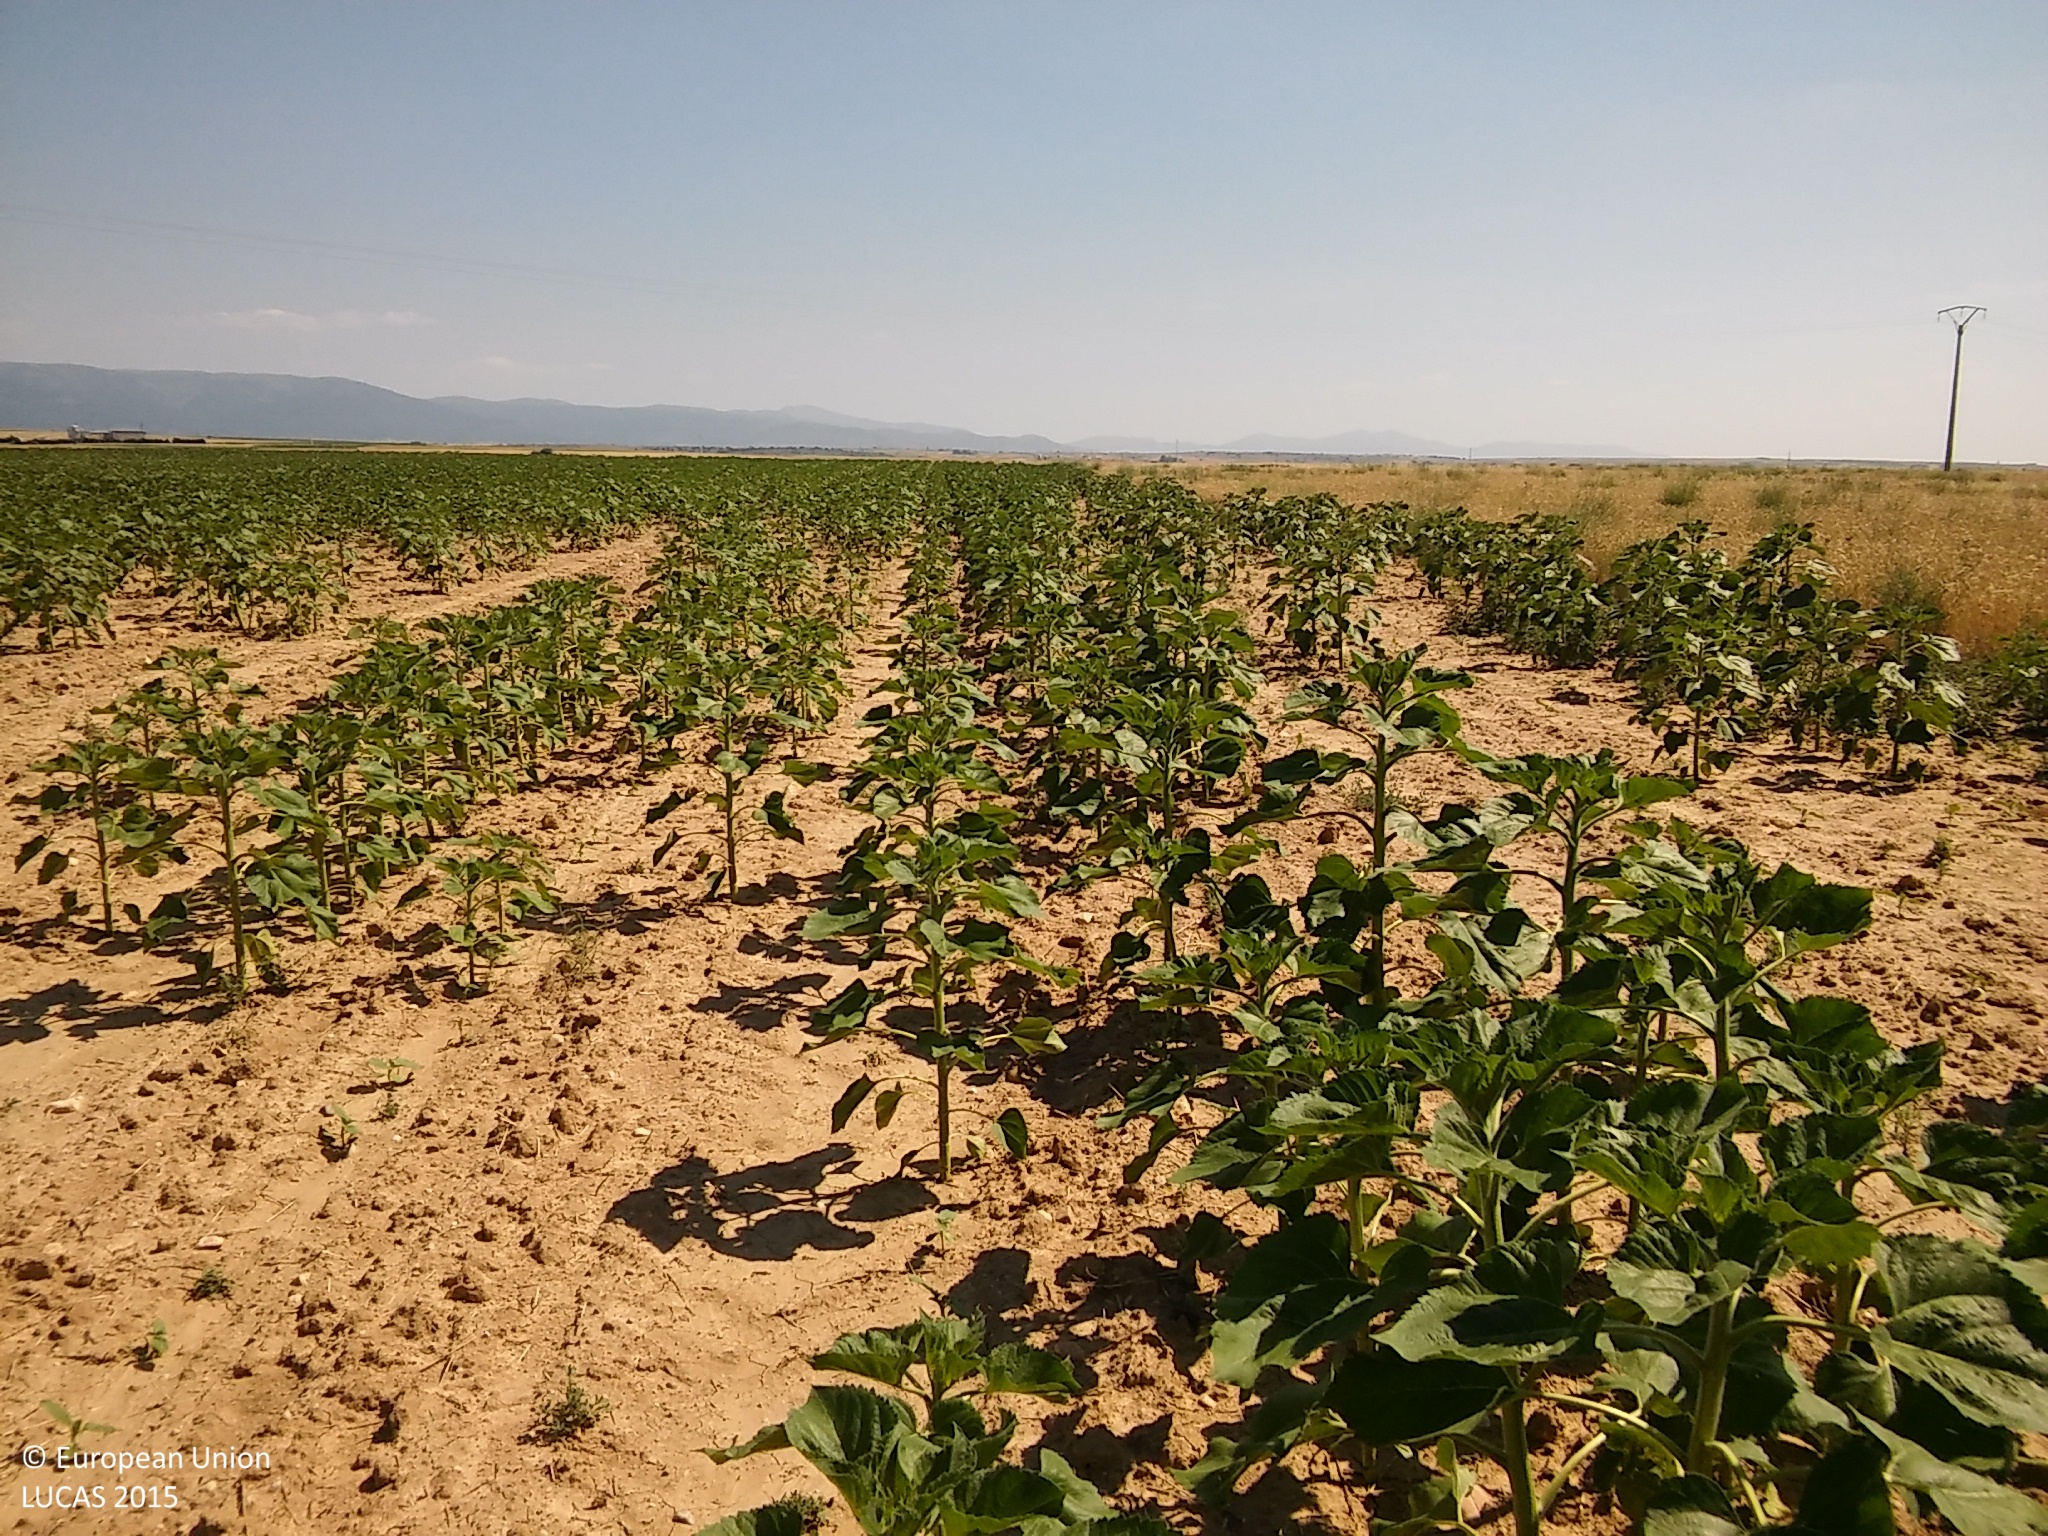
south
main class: Cropland
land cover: Sunflower
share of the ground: 25 - 50 %
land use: Agriculture (excluding fallow land and kitchen gardens)
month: June
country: ES
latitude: 41.1660
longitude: -3.9837
